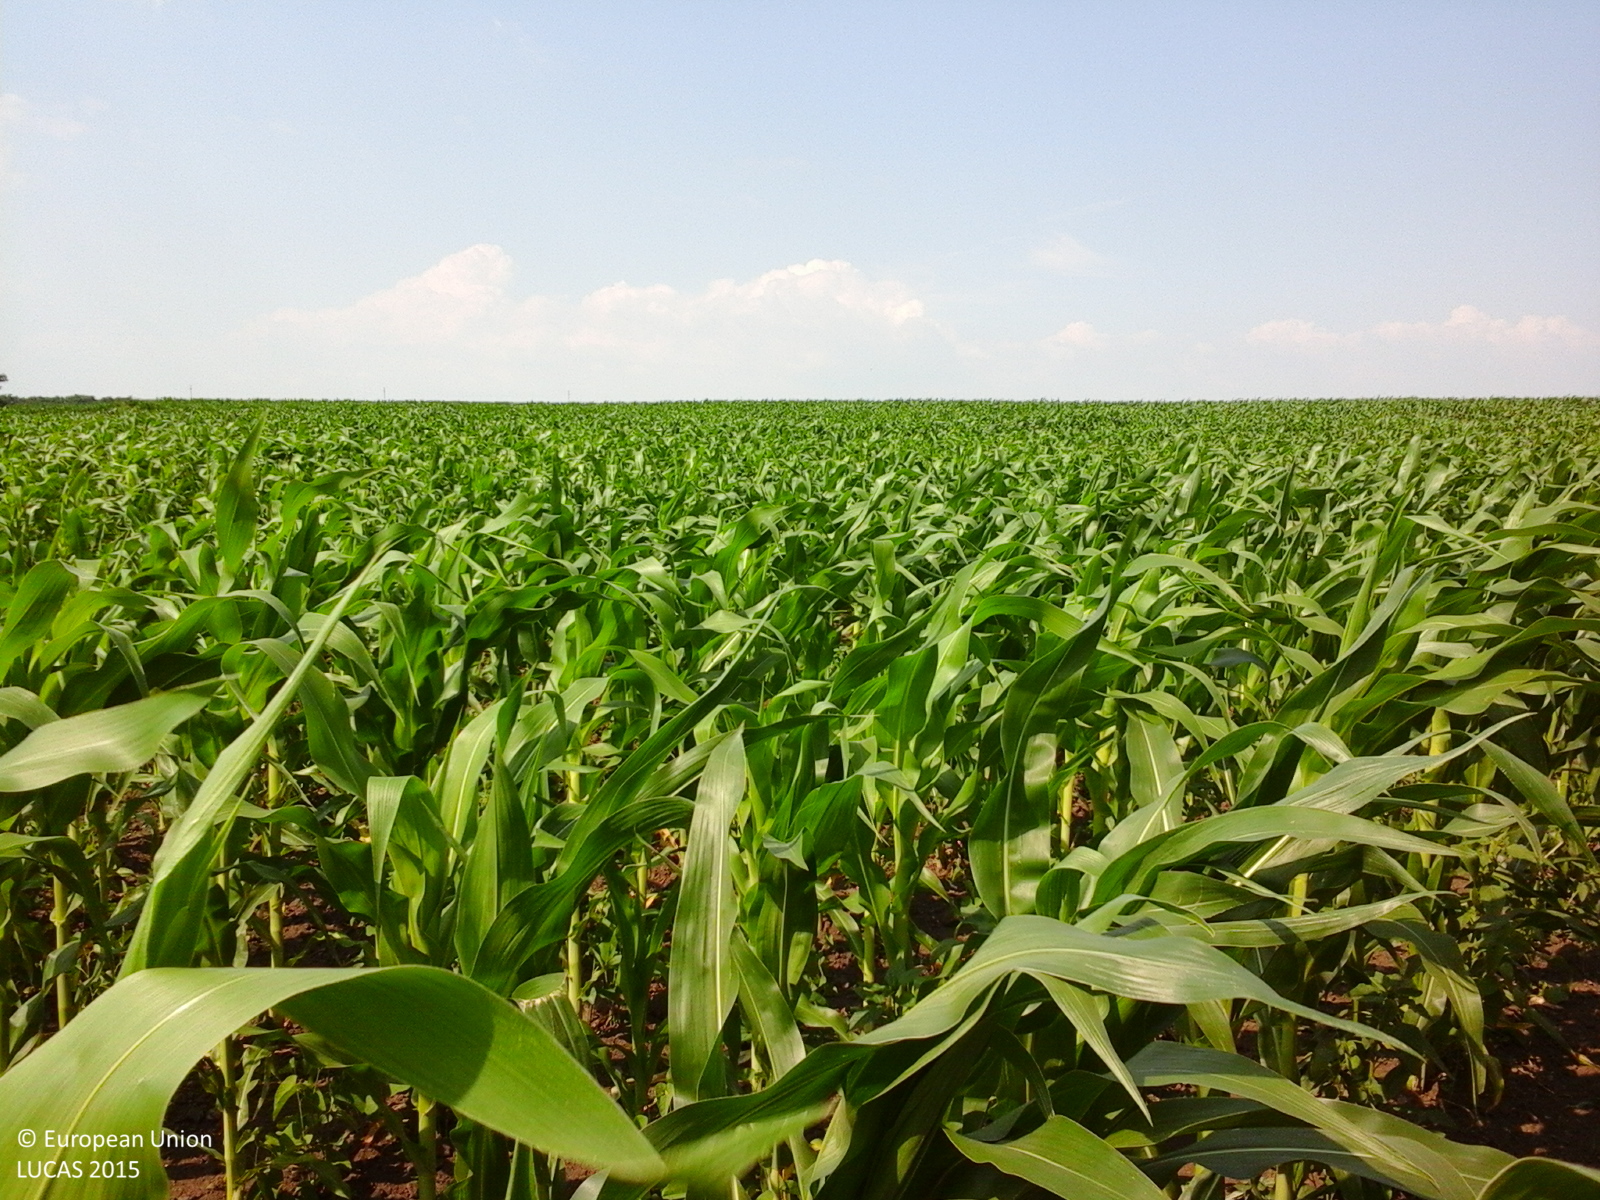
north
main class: Cropland
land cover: Maize
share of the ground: > 75 %
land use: Agriculture (excluding fallow land and kitchen gardens)
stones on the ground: < 10 %
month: June
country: RO
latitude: 47.3261
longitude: 27.4899
